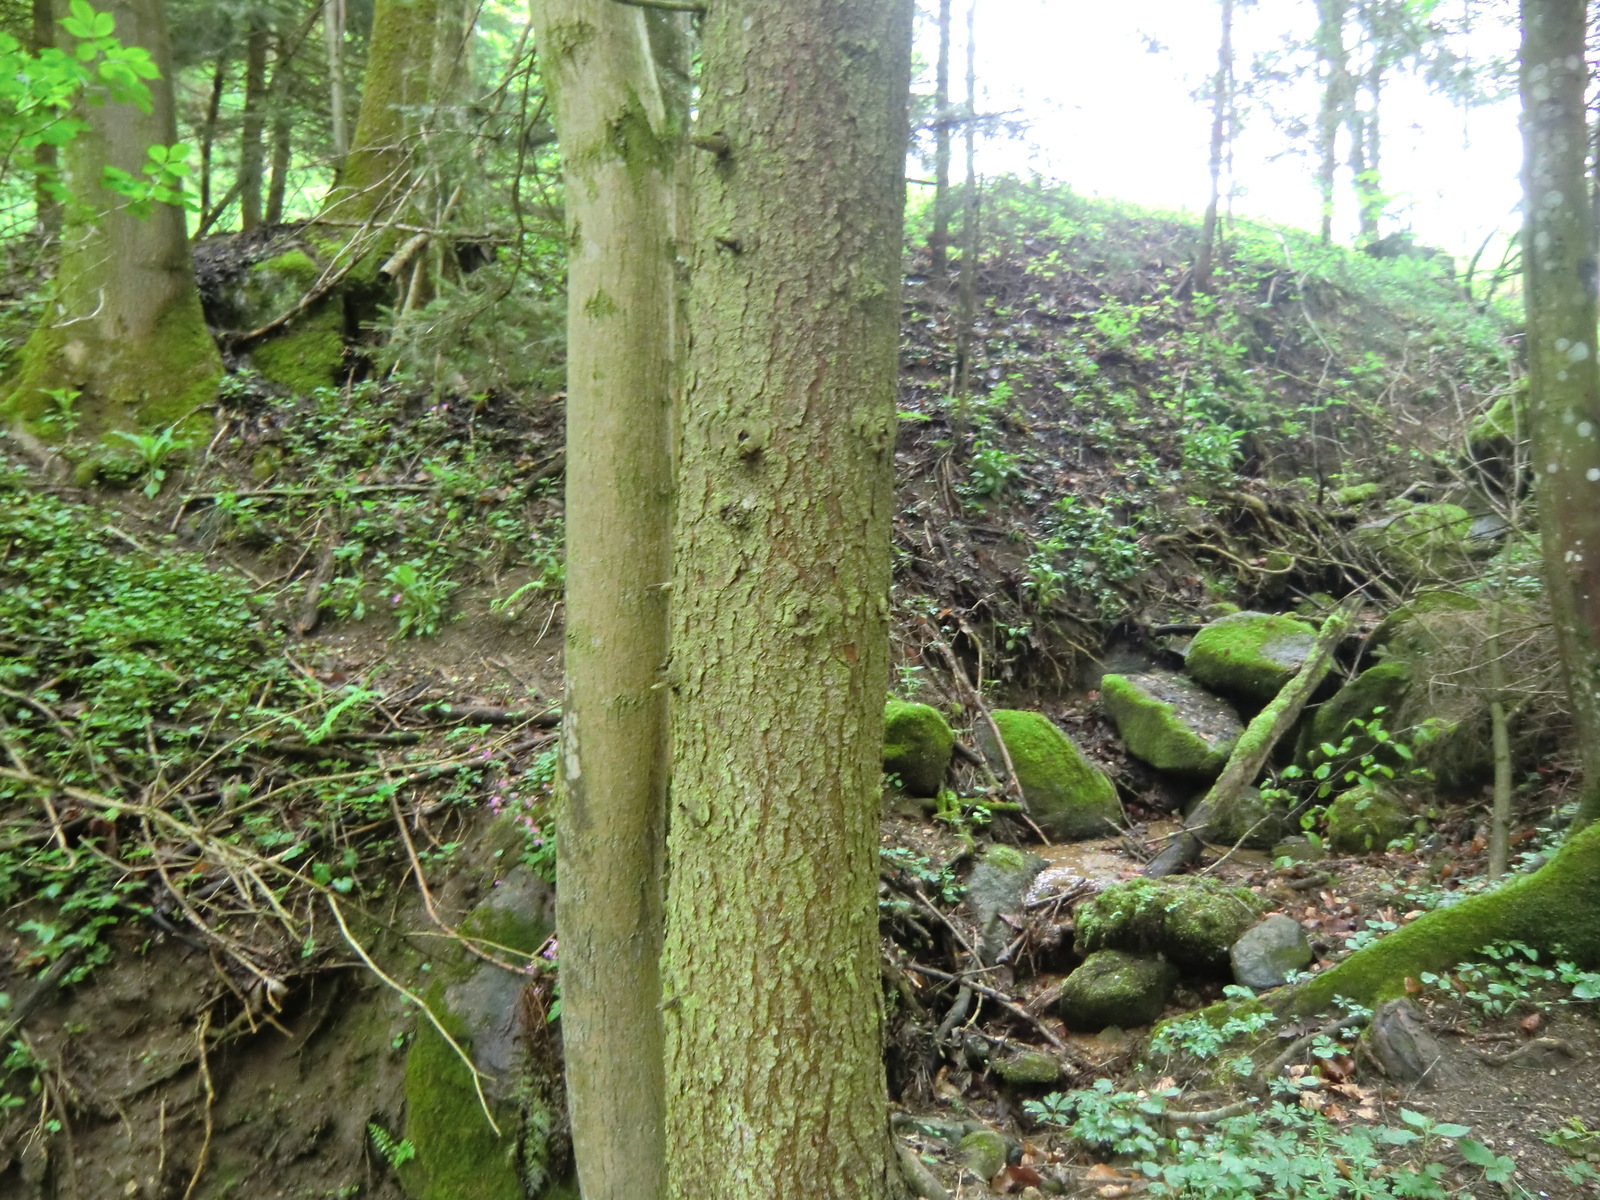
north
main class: Woodland
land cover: Spruce dominated mixed woodland
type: mountainous beech forest
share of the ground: 50 - 75 %
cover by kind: coniferous forest trees 35 %, broadleaved forest trees 35 %, shrubs 15 %, herbaceous plants 15 %
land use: Forestry
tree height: > 5 m
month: May
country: AT
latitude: 48.2831
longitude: 14.7580
